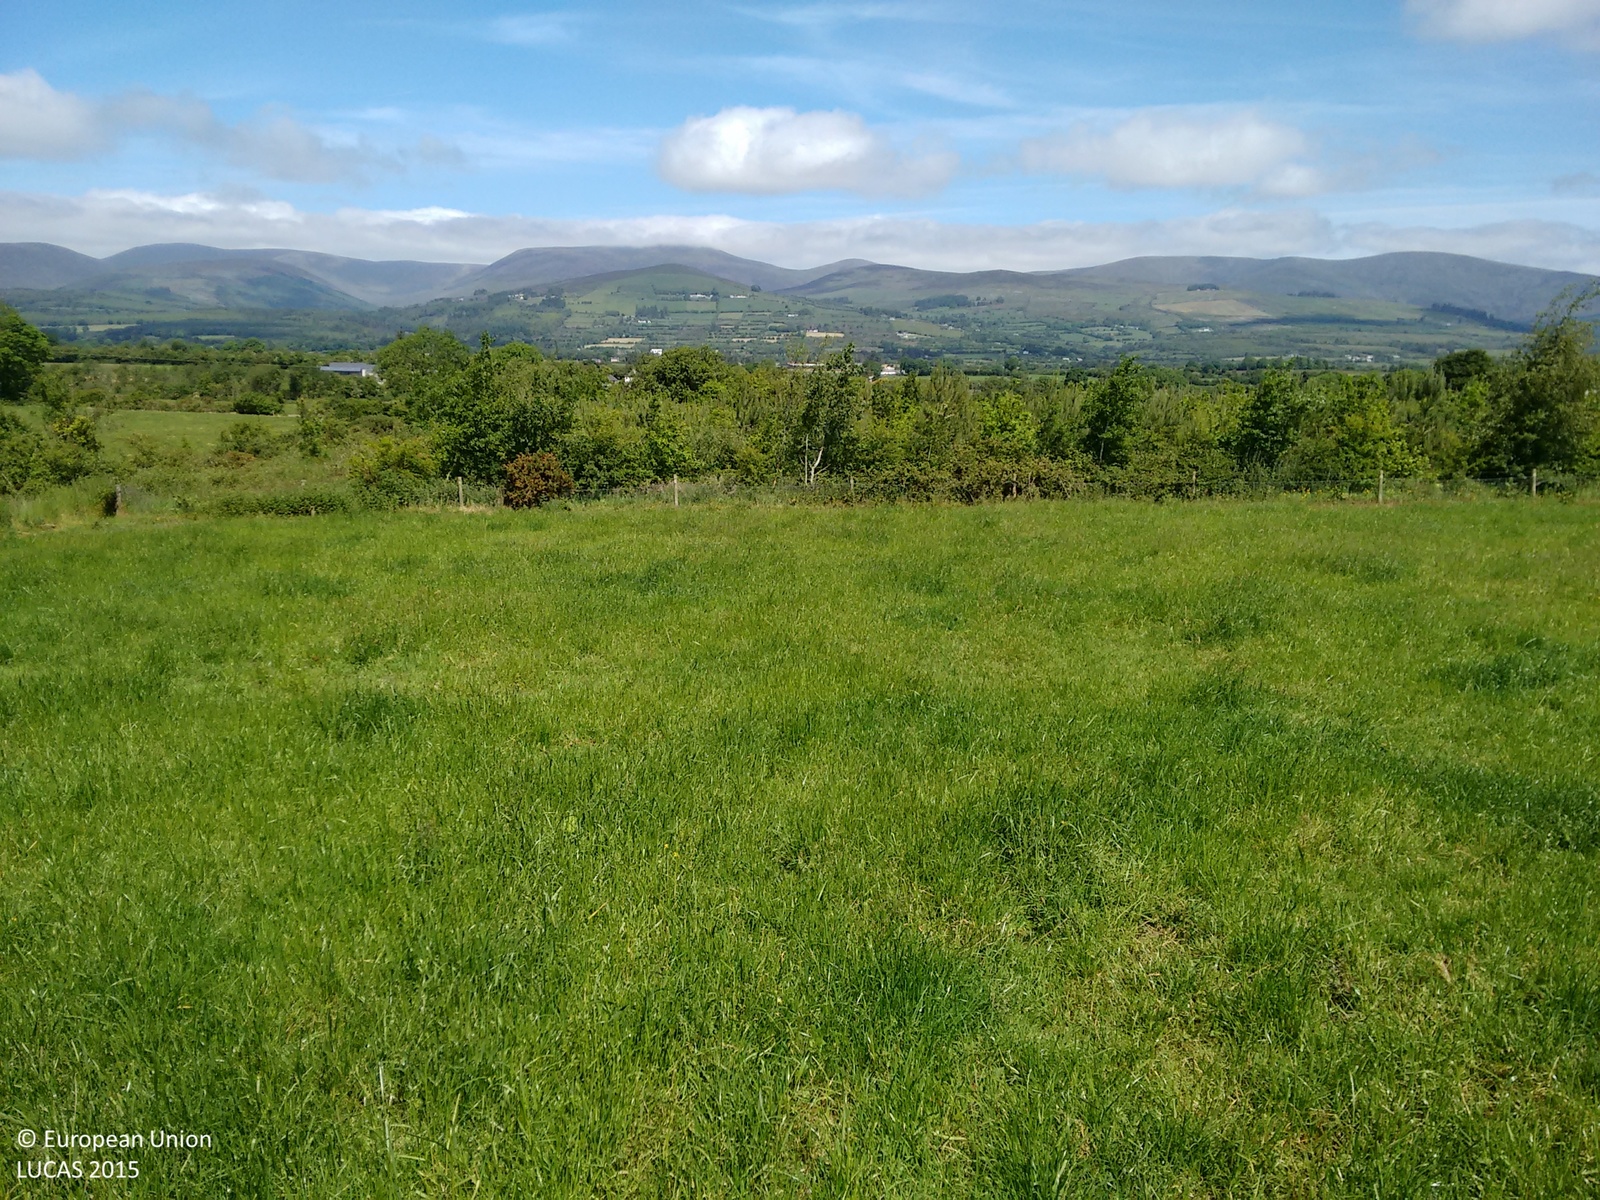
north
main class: Grassland
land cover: Grassland without tree/shrub cover
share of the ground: > 75 %
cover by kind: herbaceous plants 100 %
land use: Agriculture (excluding fallow land and kitchen gardens)
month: June
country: IE
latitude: 52.2910
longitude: -8.1411
